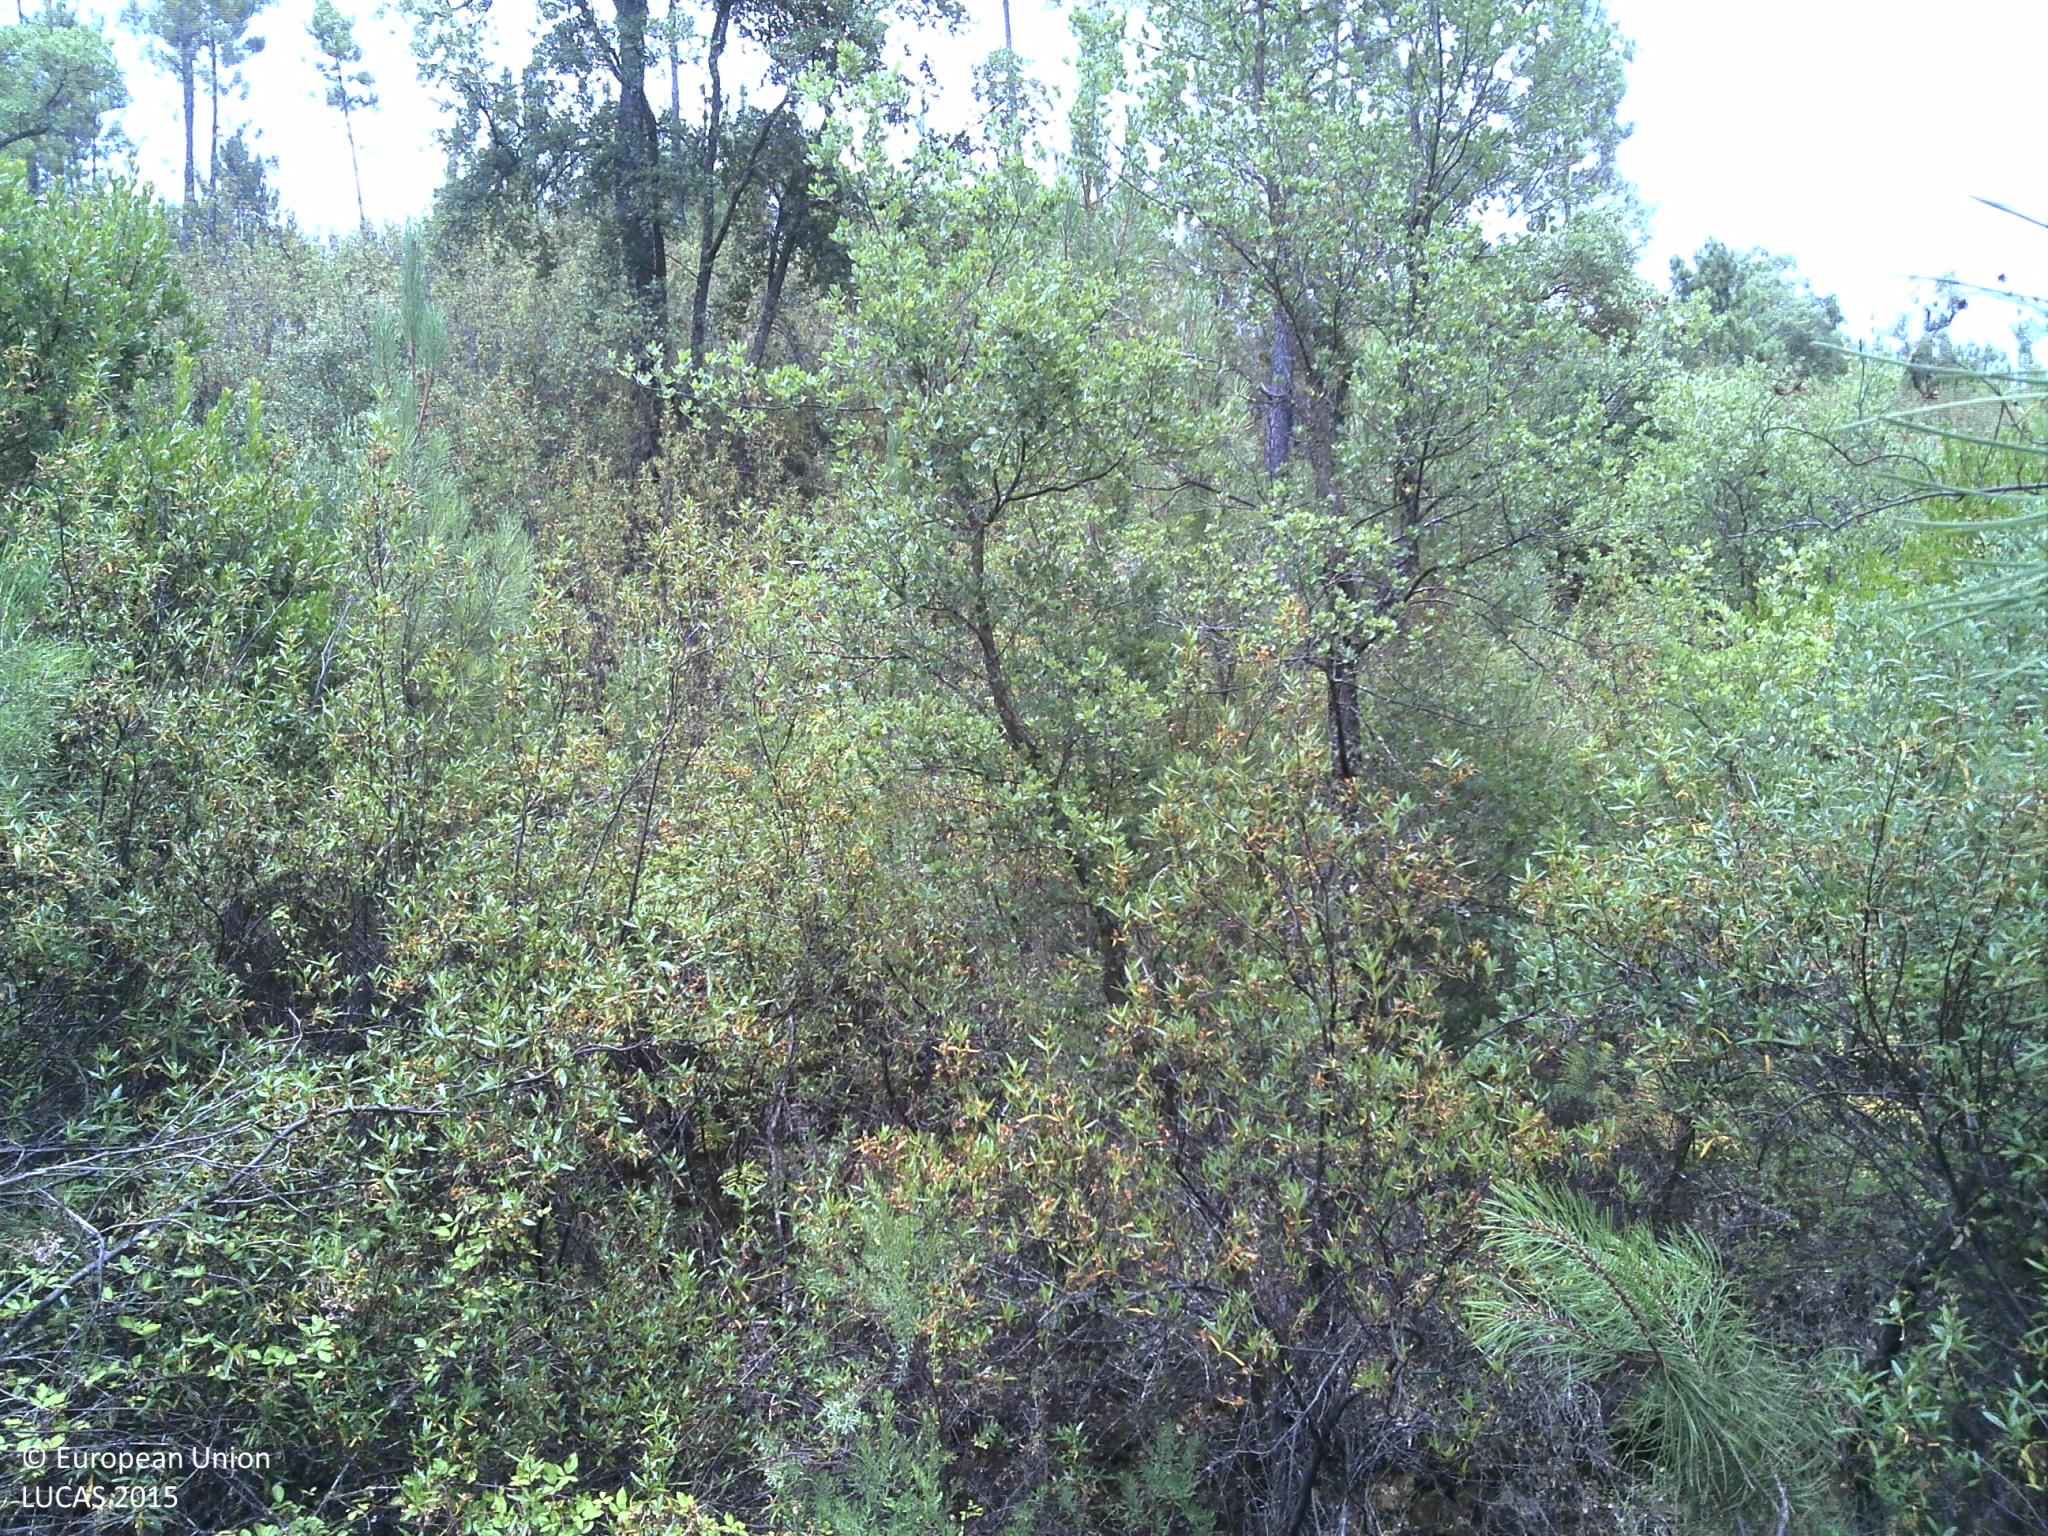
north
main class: Woodland
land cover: Broadleaved woodland
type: thermophilous deciduous forest
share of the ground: 25 - 50 %
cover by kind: shrubs 70 %, broadleaved forest trees 25 %, coniferous forest trees 5 %
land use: Forestry
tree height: > 5 m
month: July
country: PT
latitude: 39.6944
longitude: -8.1058
